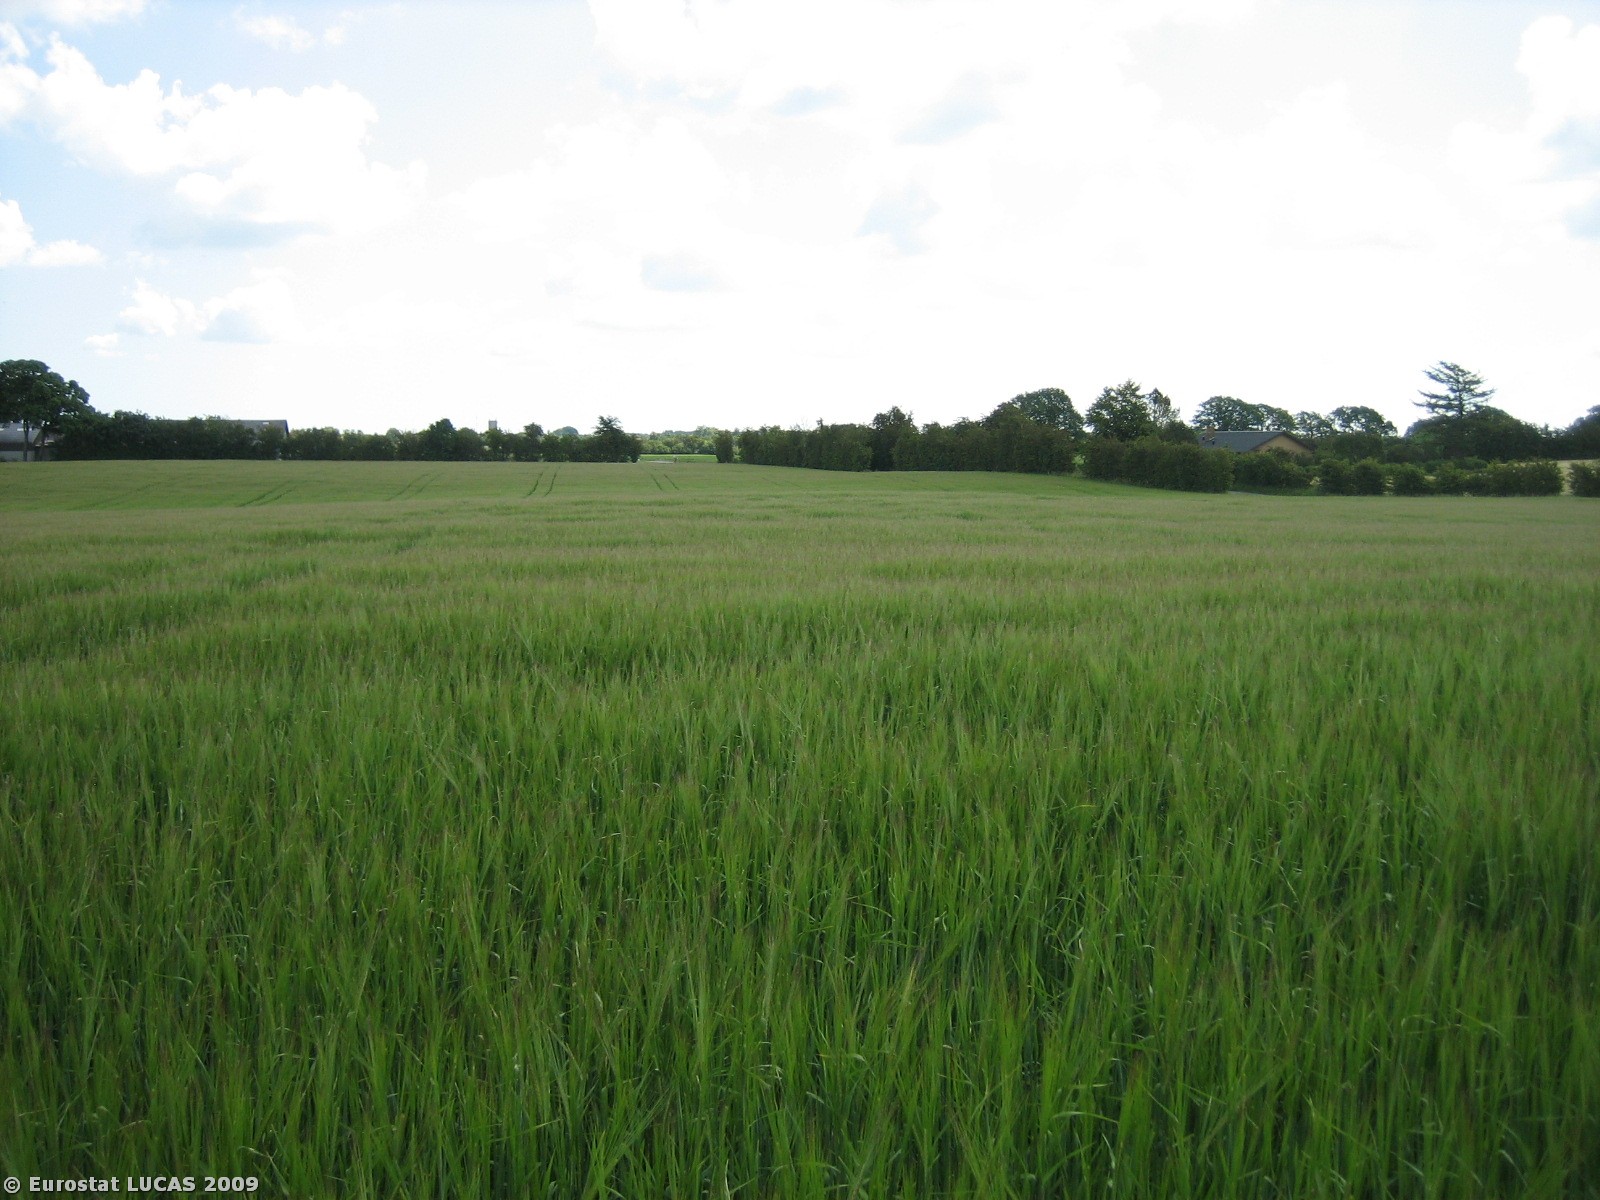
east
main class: Cropland
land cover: Barley
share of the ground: > 75 %
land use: Agriculture (excluding fallow land and kitchen gardens)
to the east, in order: Barley
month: June
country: DK
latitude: 55.5566
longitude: 9.2873
